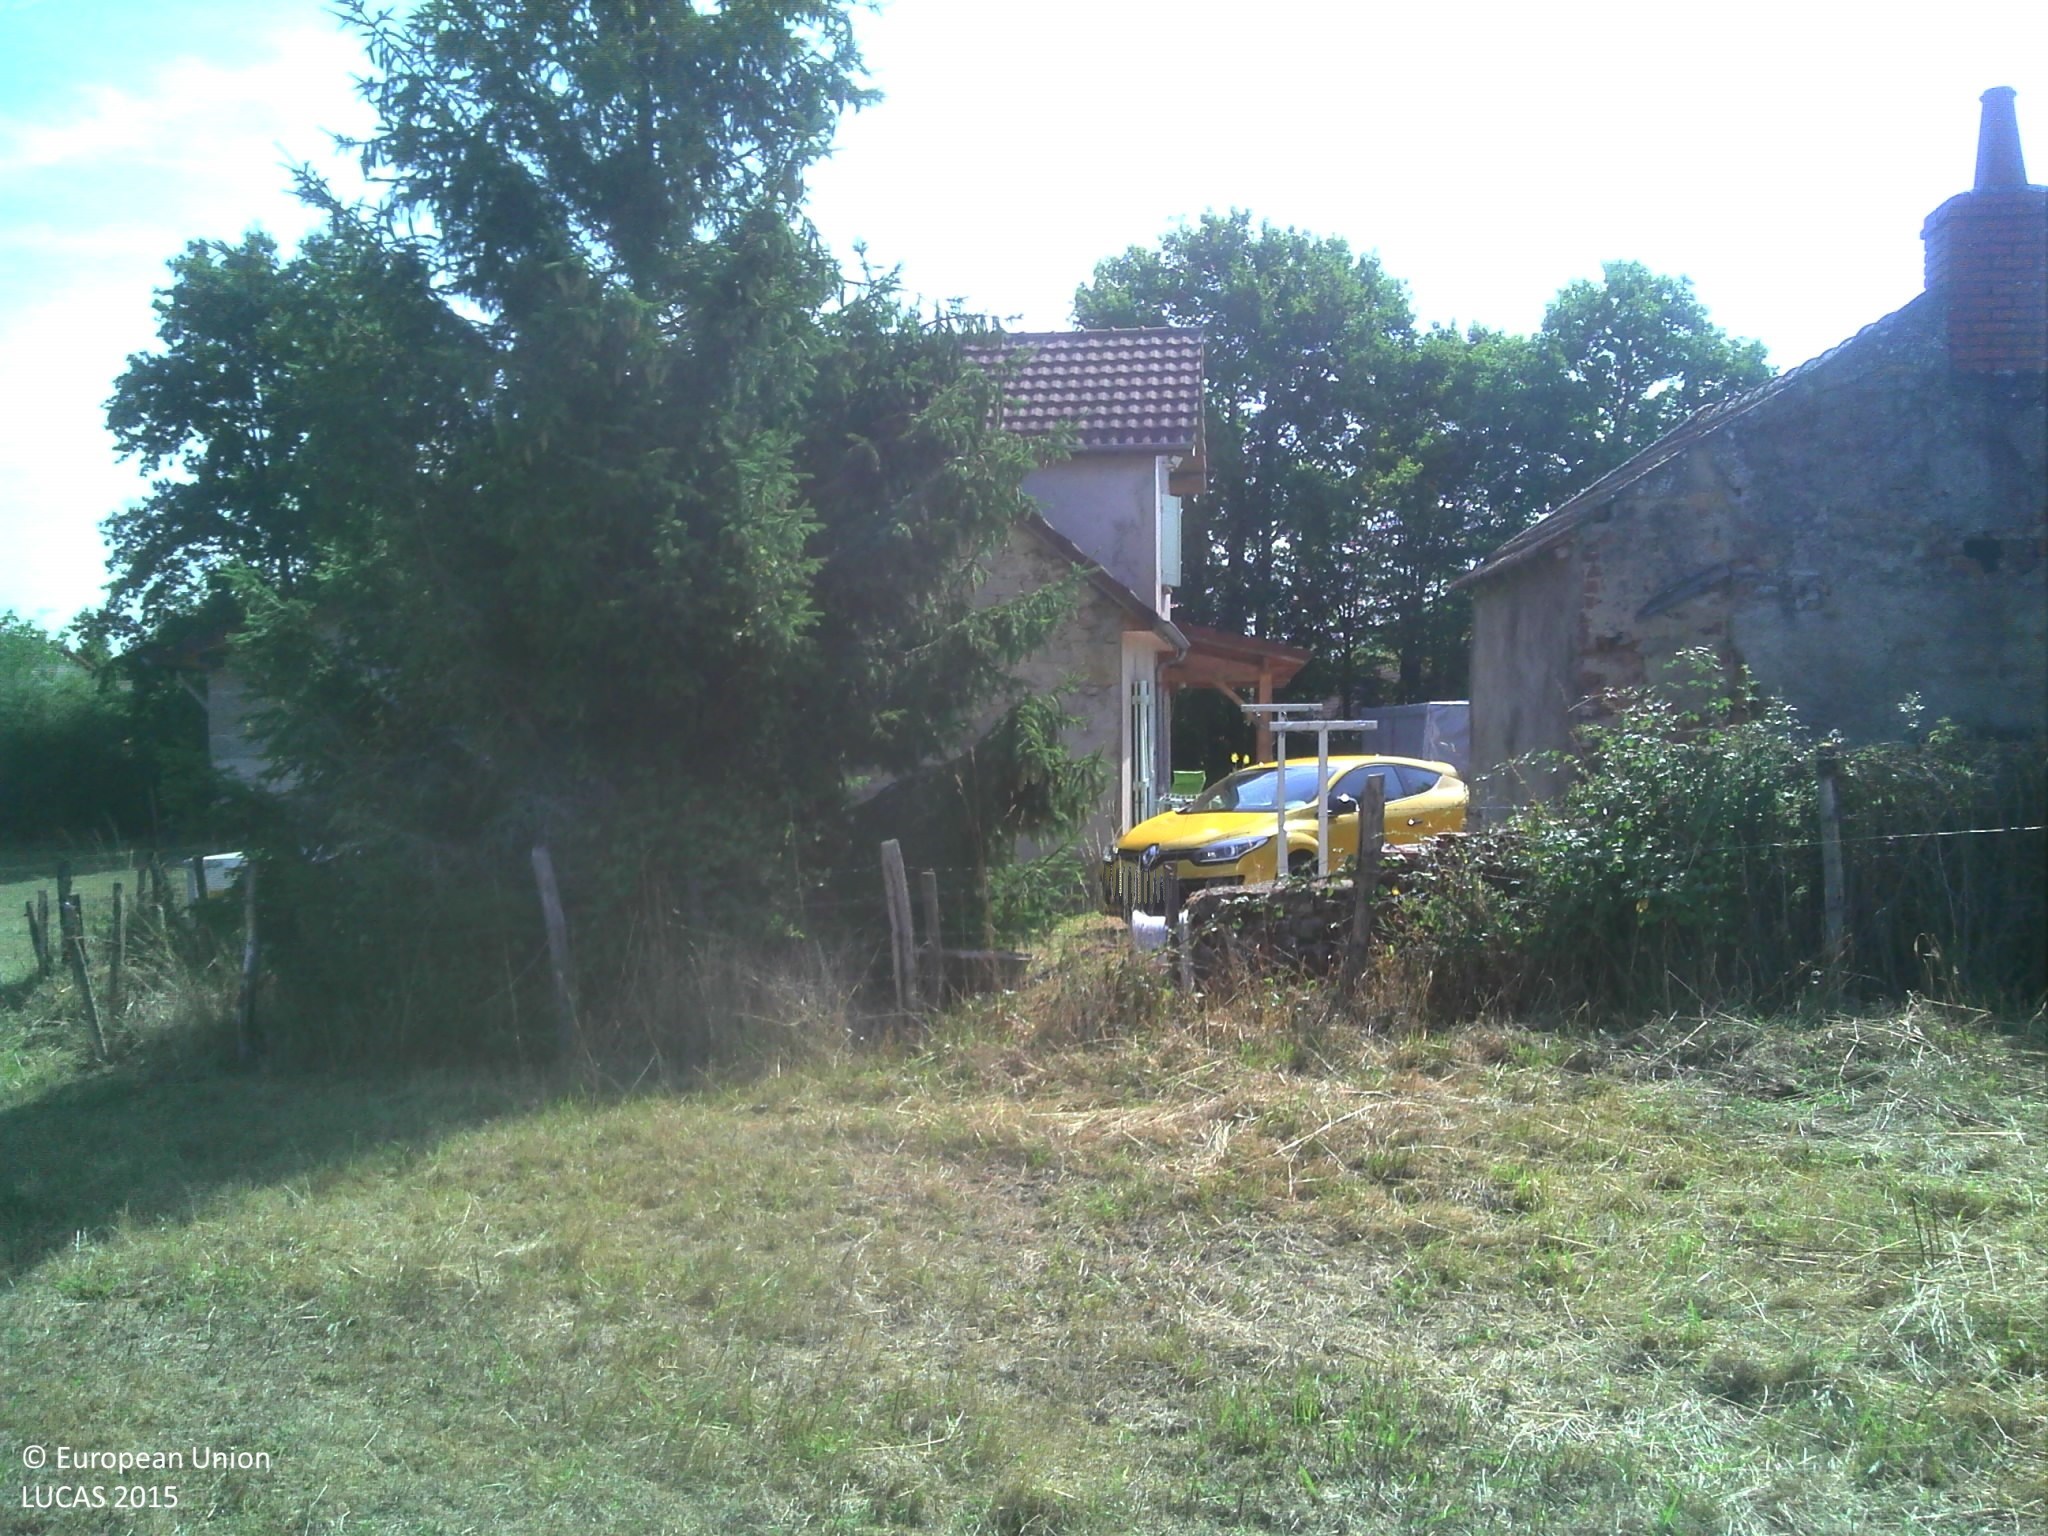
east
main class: Grassland
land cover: Grassland without tree/shrub cover
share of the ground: > 75 %
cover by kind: herbaceous plants 100 %
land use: Agriculture (excluding fallow land and kitchen gardens)
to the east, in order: Grassland without tree/shrub cover; Artificial constructions in urban areas
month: August
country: FR
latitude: 46.7094
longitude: 4.3891
